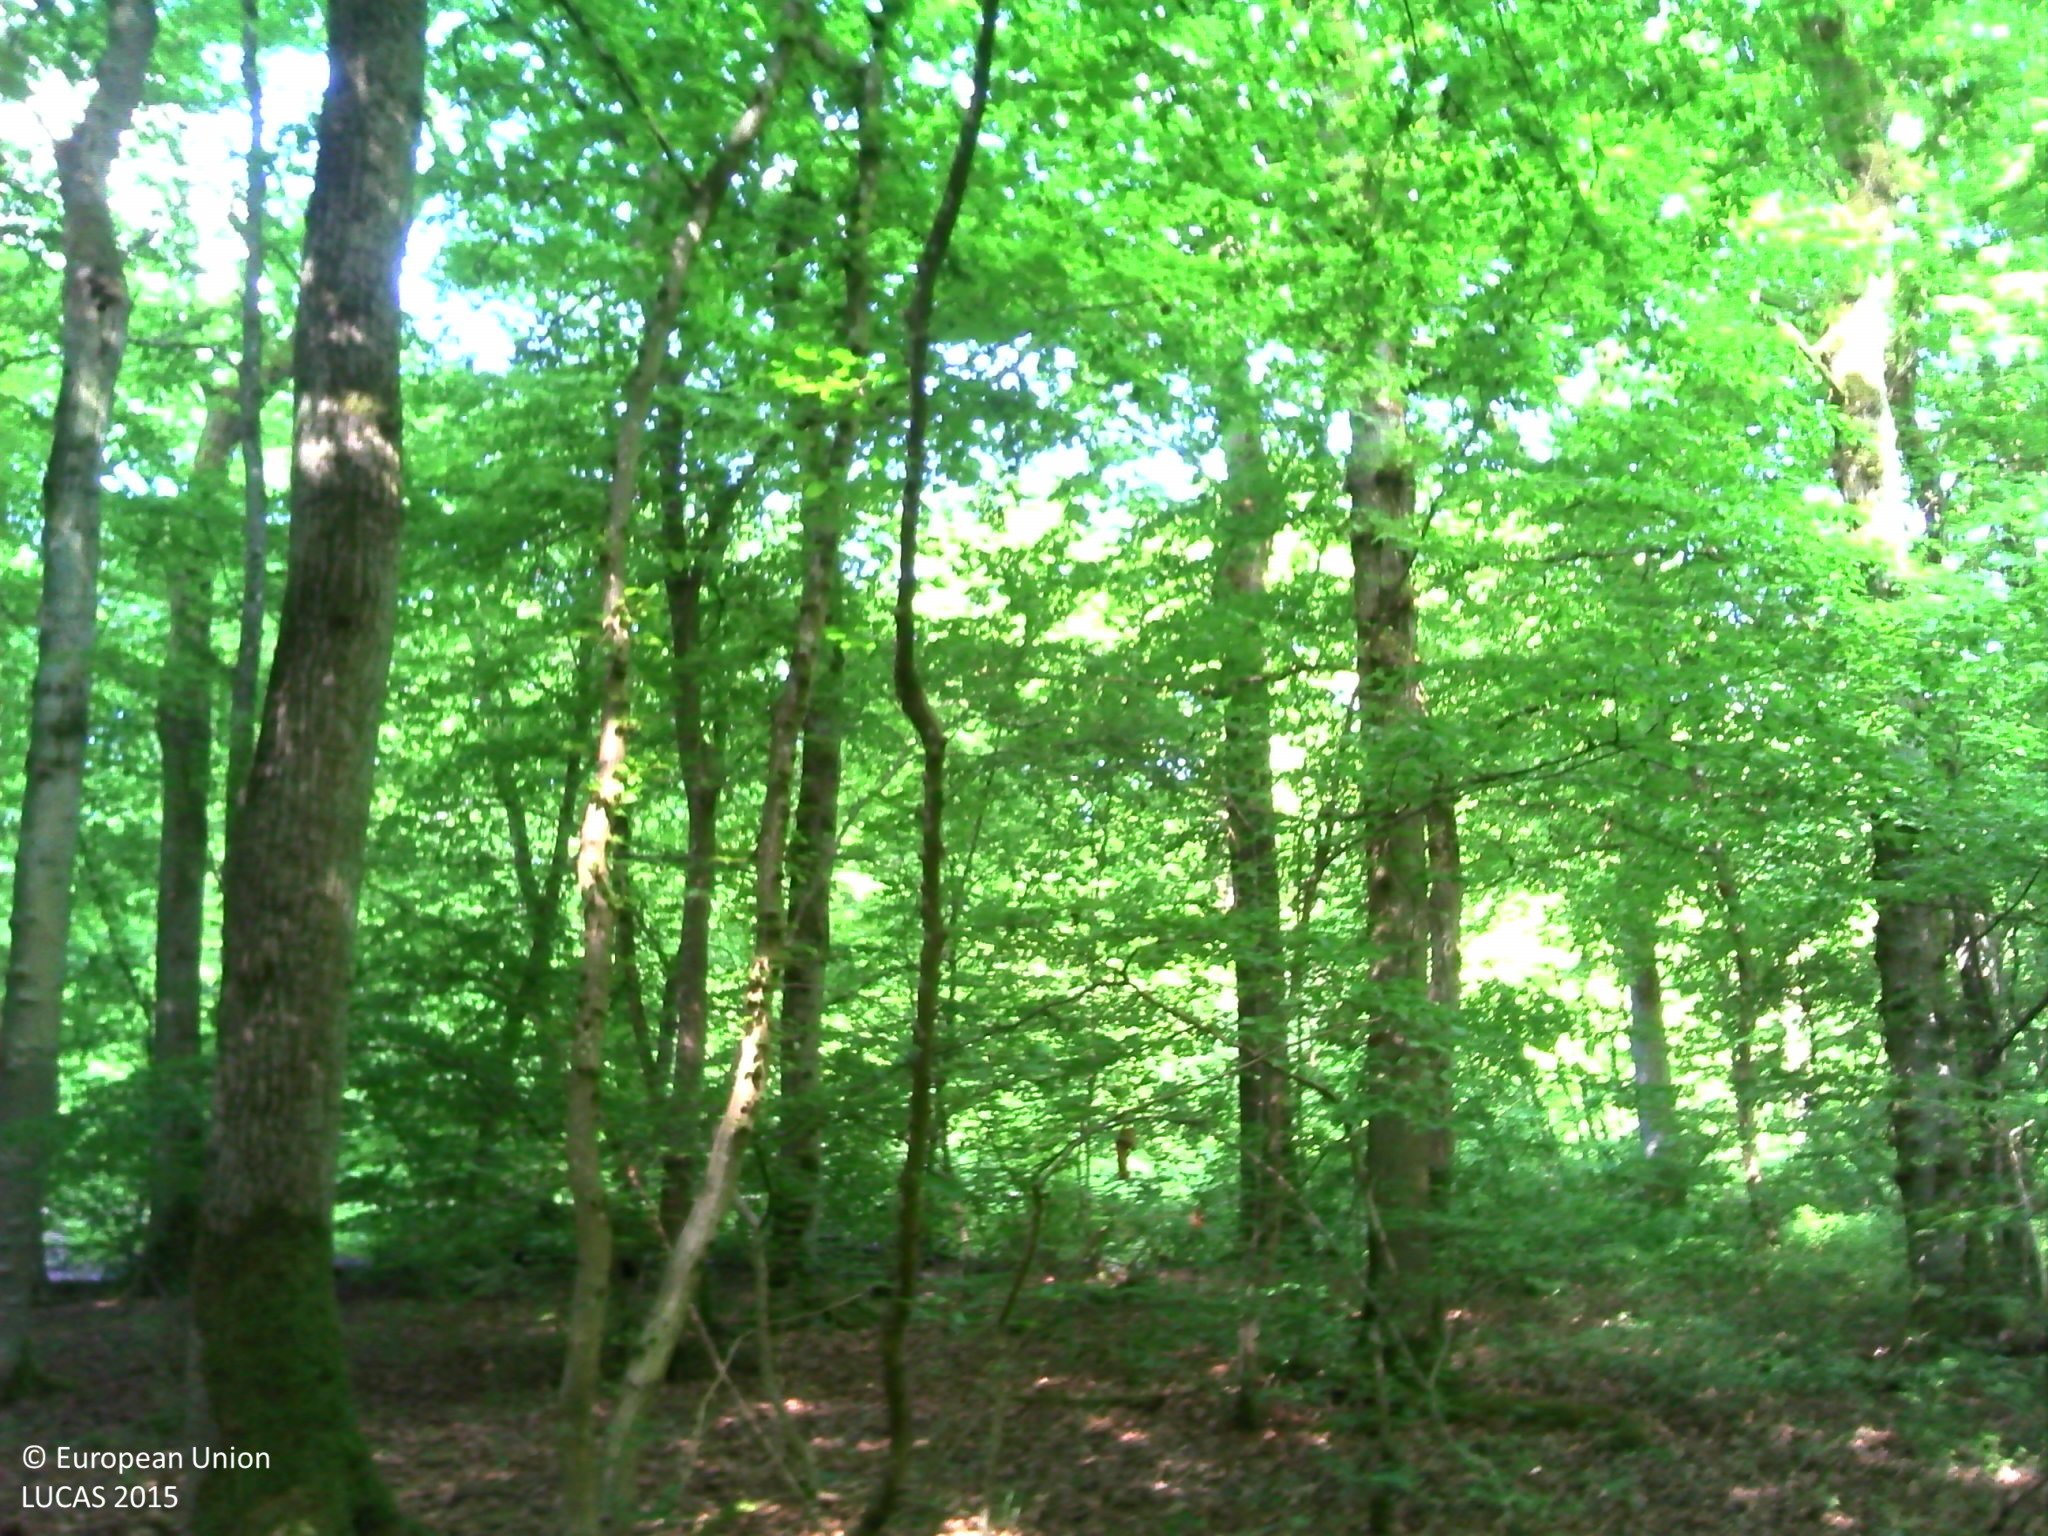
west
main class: Woodland
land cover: Broadleaved woodland
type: mesophytic deciduous forest
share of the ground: > 75 %
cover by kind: broadleaved forest trees 95 %, lichens and mosses 5 %
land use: Forestry
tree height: > 5 m
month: May
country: LU
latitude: 49.4881
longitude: 6.1204
